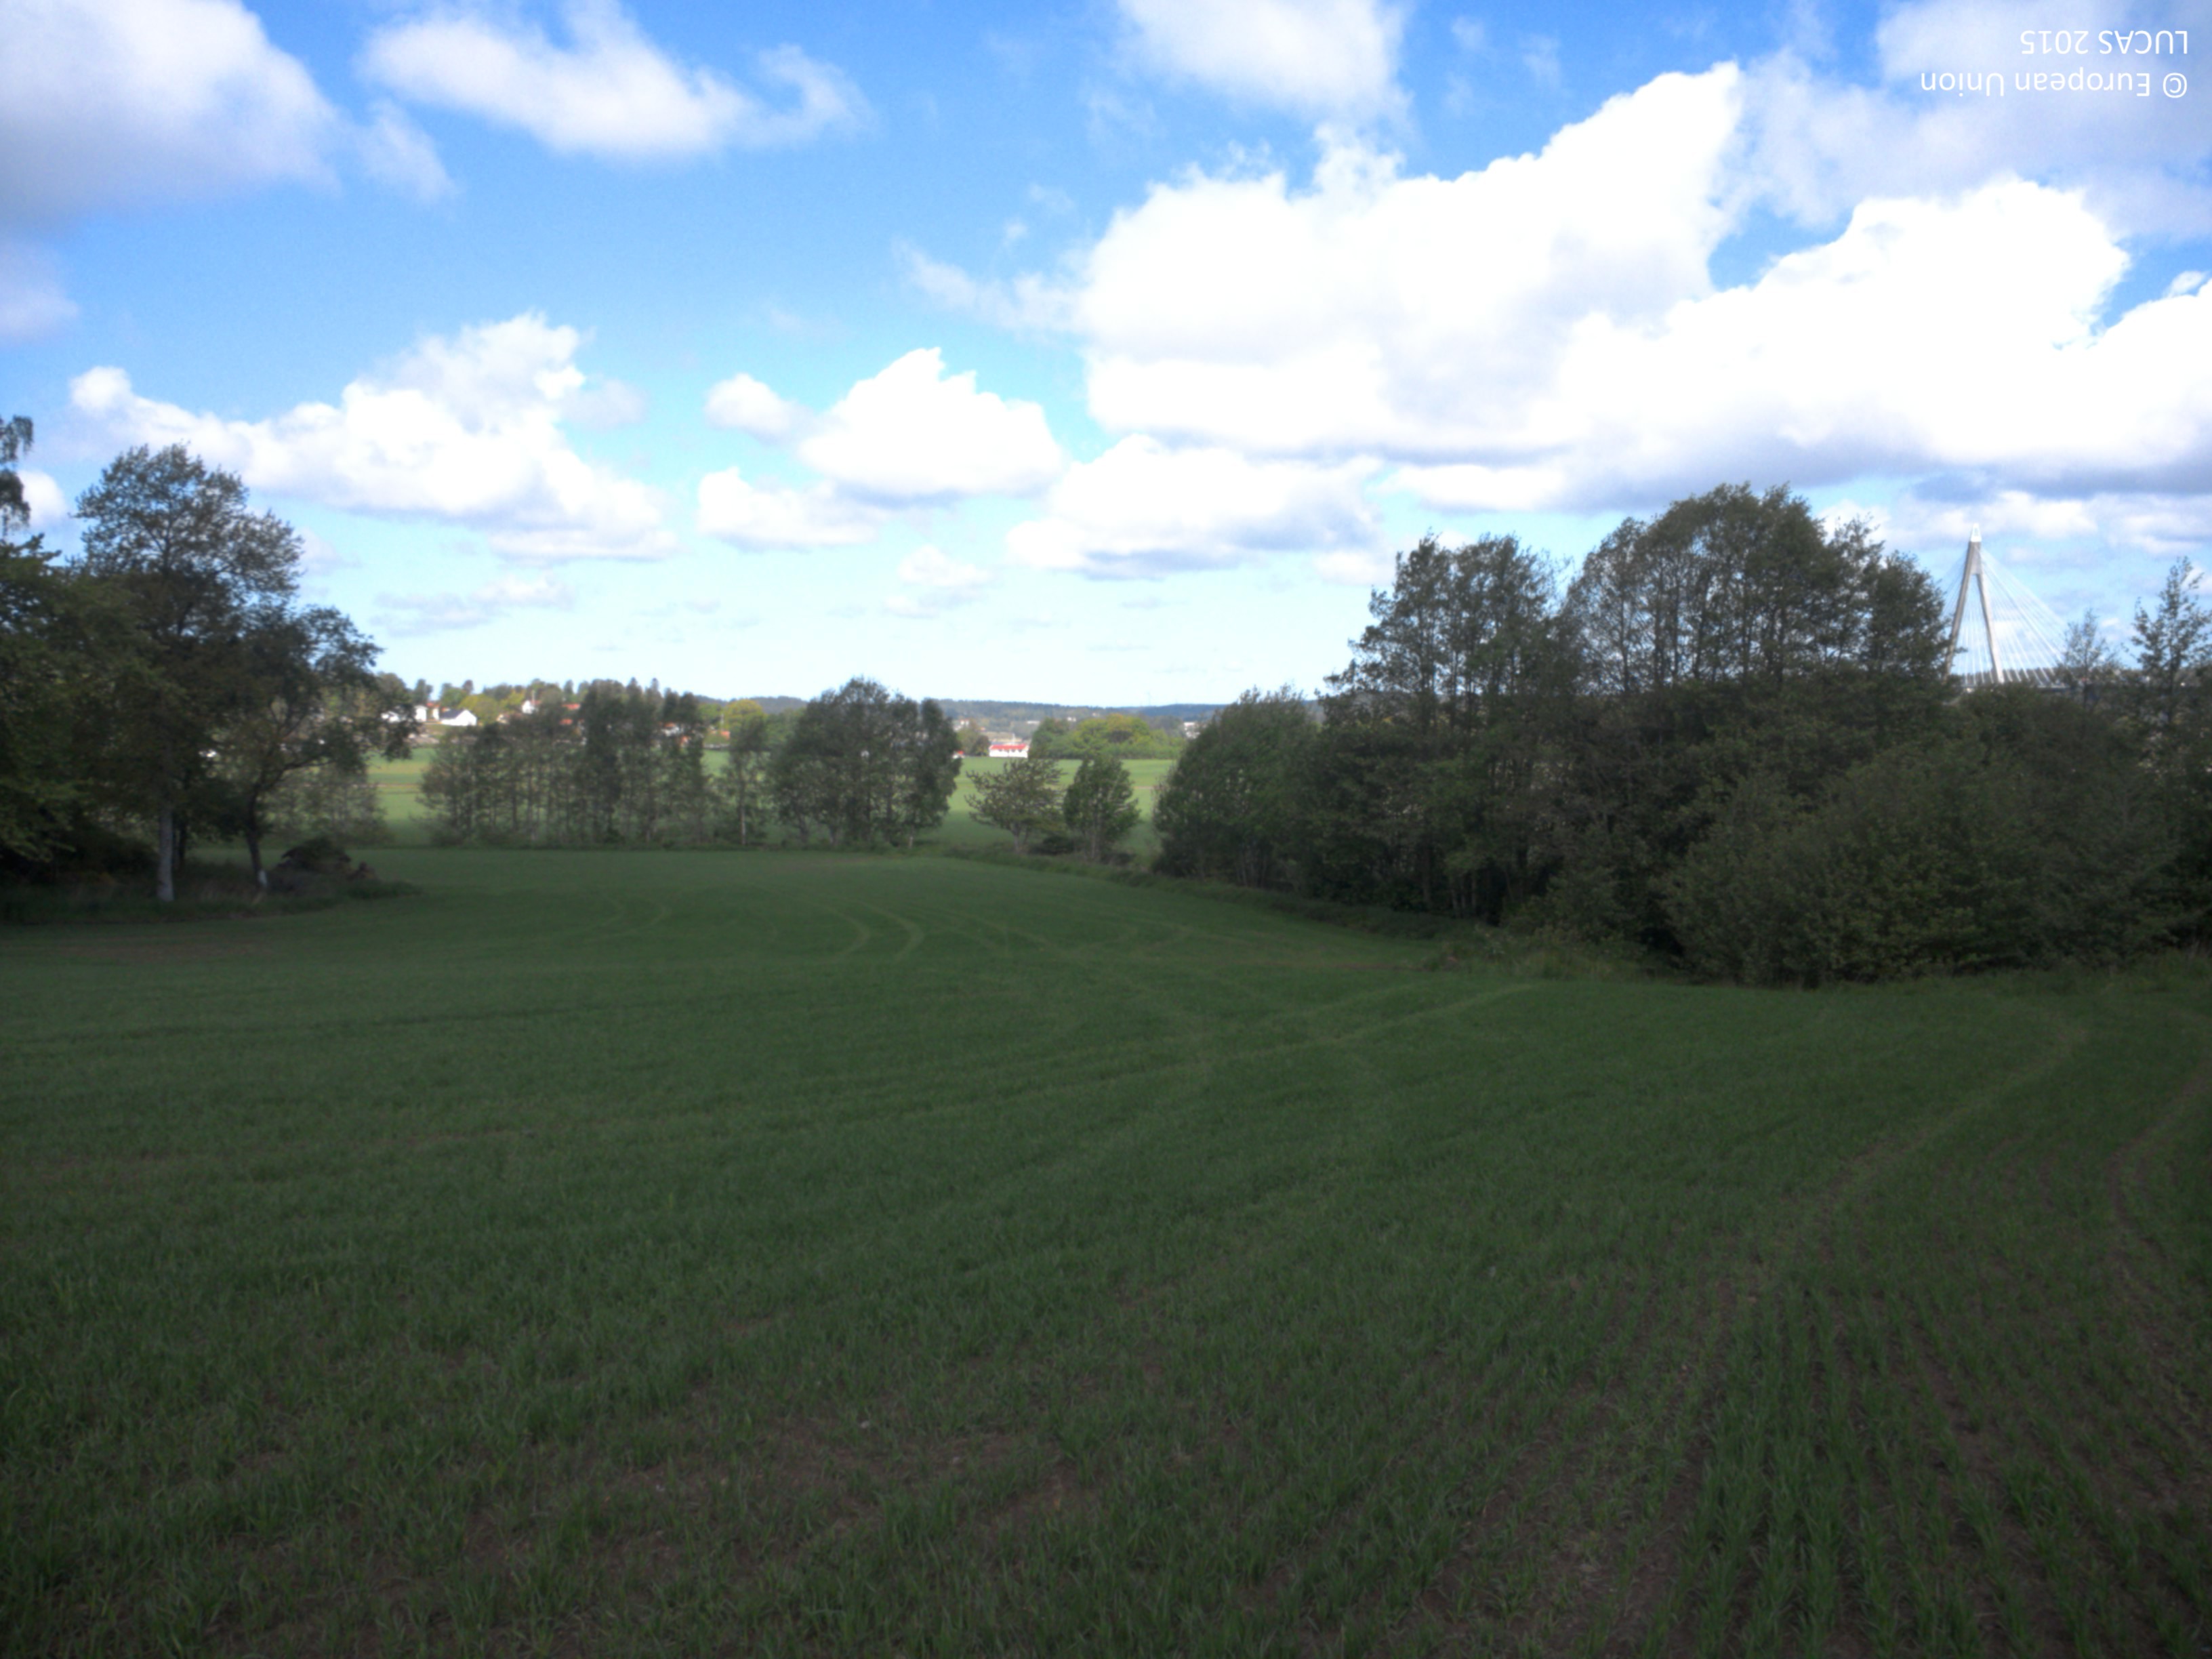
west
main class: Cropland
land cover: Common wheat
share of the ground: 50 - 75 %
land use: Agriculture (excluding fallow land and kitchen gardens)
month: June
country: SE
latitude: 58.3146
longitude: 11.8568
